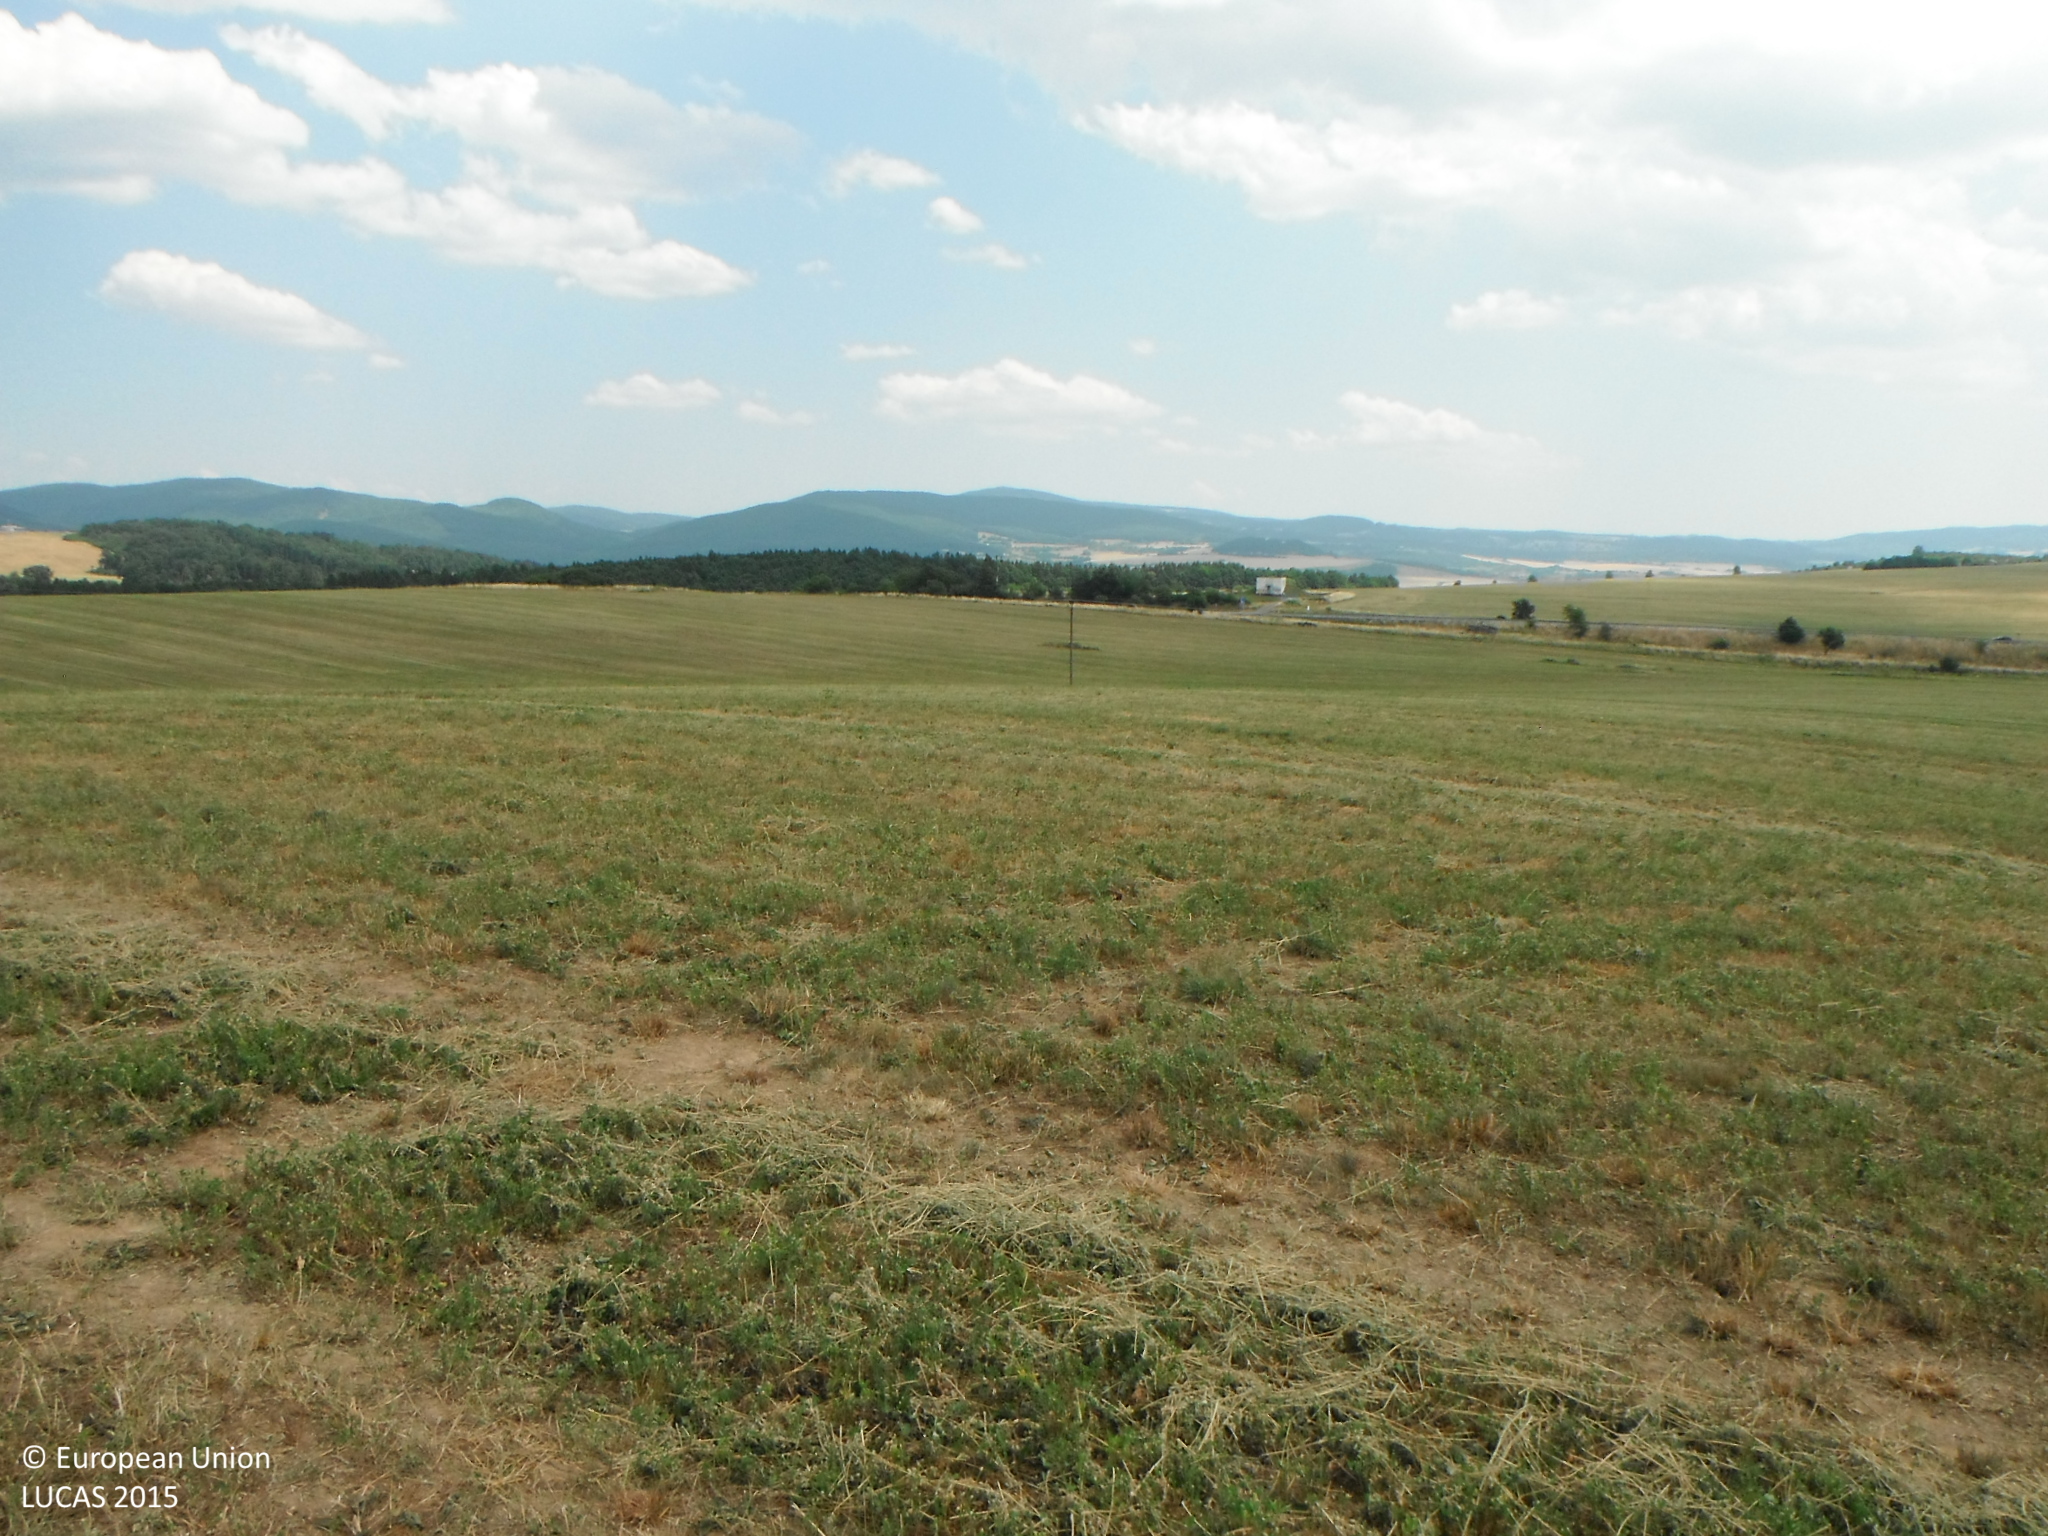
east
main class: Cropland
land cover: Lucerne
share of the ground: > 75 %
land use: Agriculture (excluding fallow land and kitchen gardens)
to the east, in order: Lucerne; Electric lines; Lucerne
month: July
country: SK
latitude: 48.4446
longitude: 19.0924
